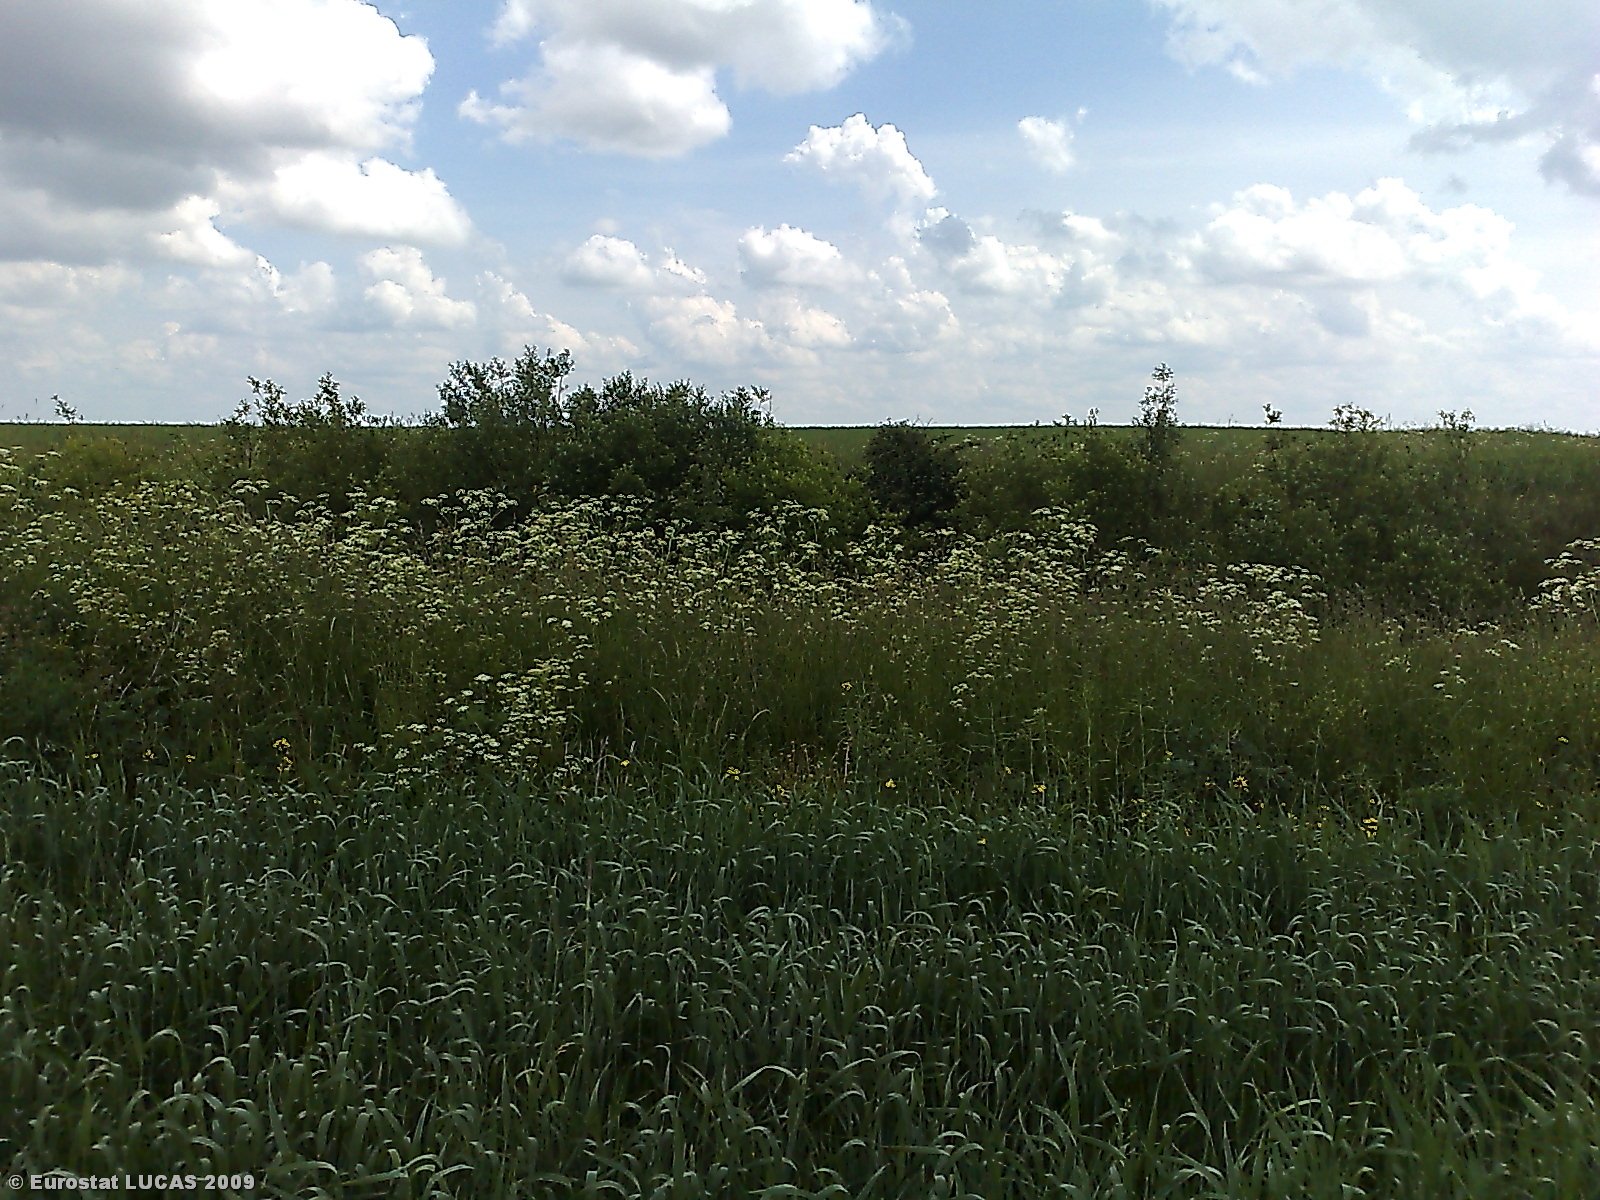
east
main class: Cropland
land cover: Common wheat
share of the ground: > 75 %
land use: Agriculture (excluding fallow land and kitchen gardens)
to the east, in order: Common wheat; Grass margins; Ditches and canals; Abandoned hedges; Grass margins; Rape and turnip rape
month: June
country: LT
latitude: 56.1699
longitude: 24.1170
